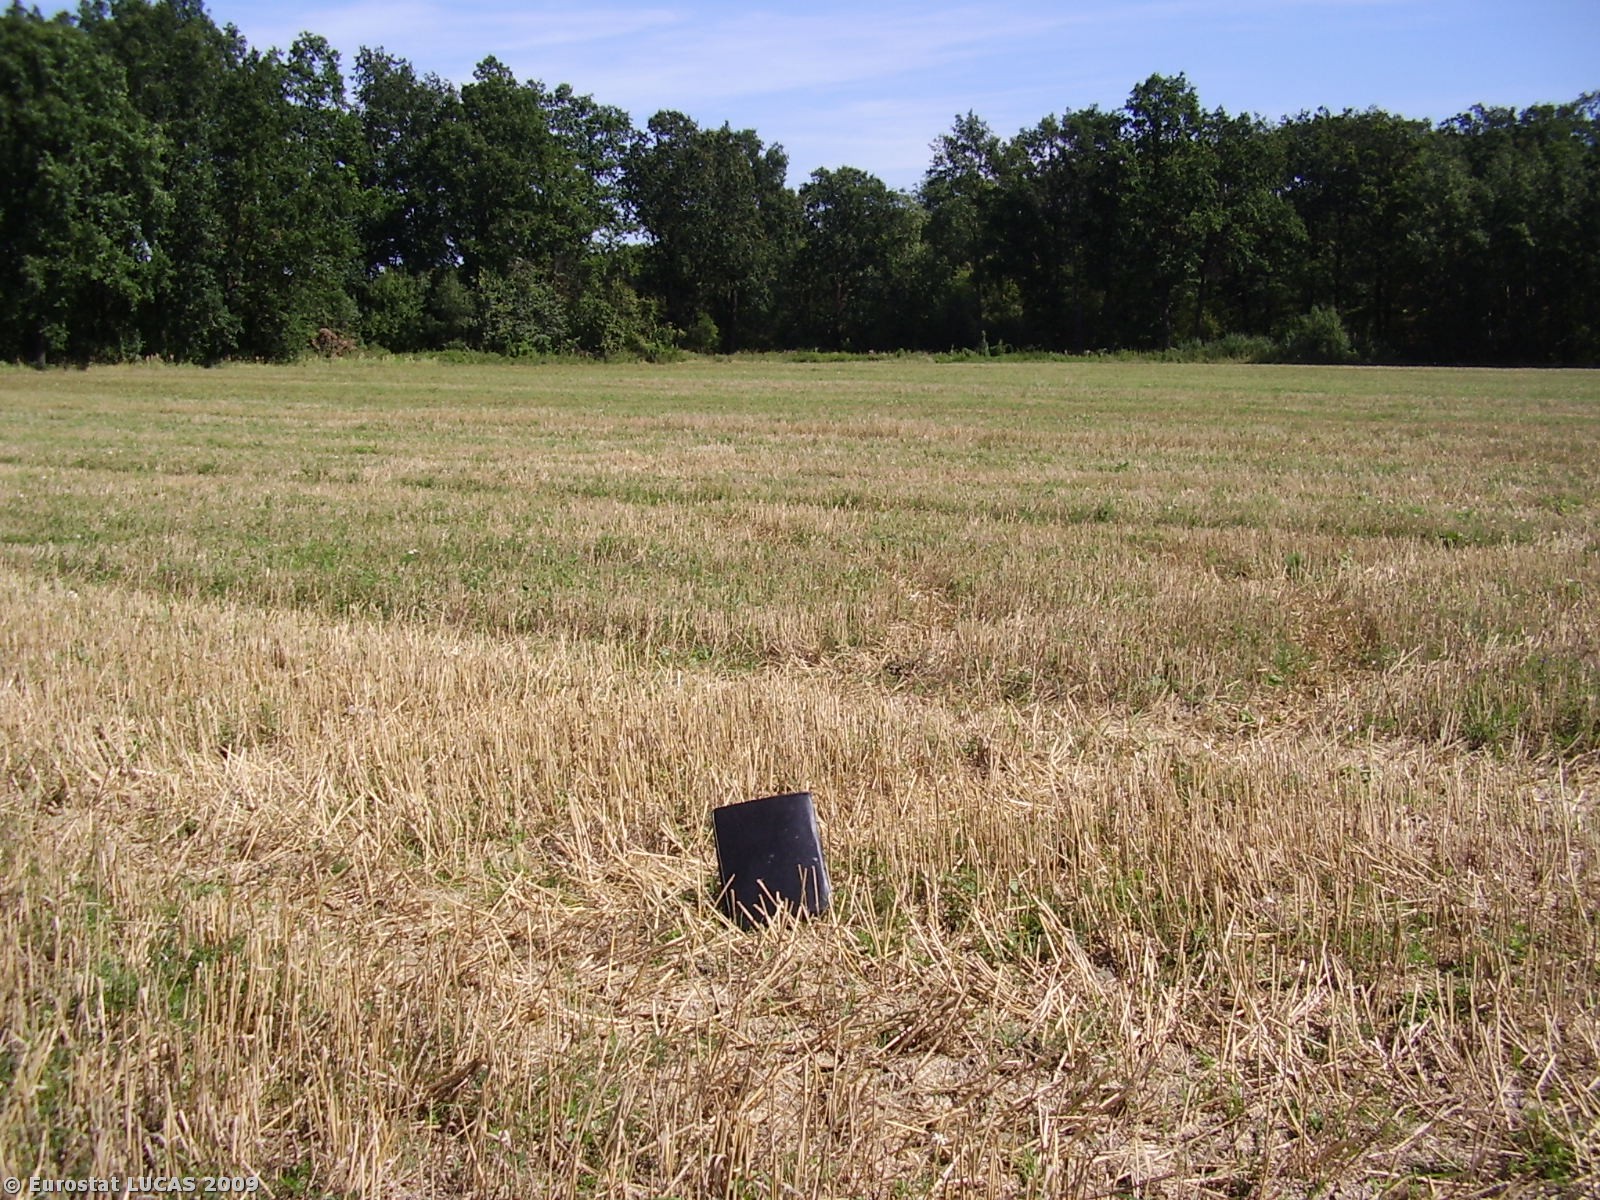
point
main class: Cropland
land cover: Common wheat
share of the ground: < 10 %
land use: Agriculture (excluding fallow land and kitchen gardens)
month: August
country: PL
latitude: 51.4062
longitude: 16.8090
